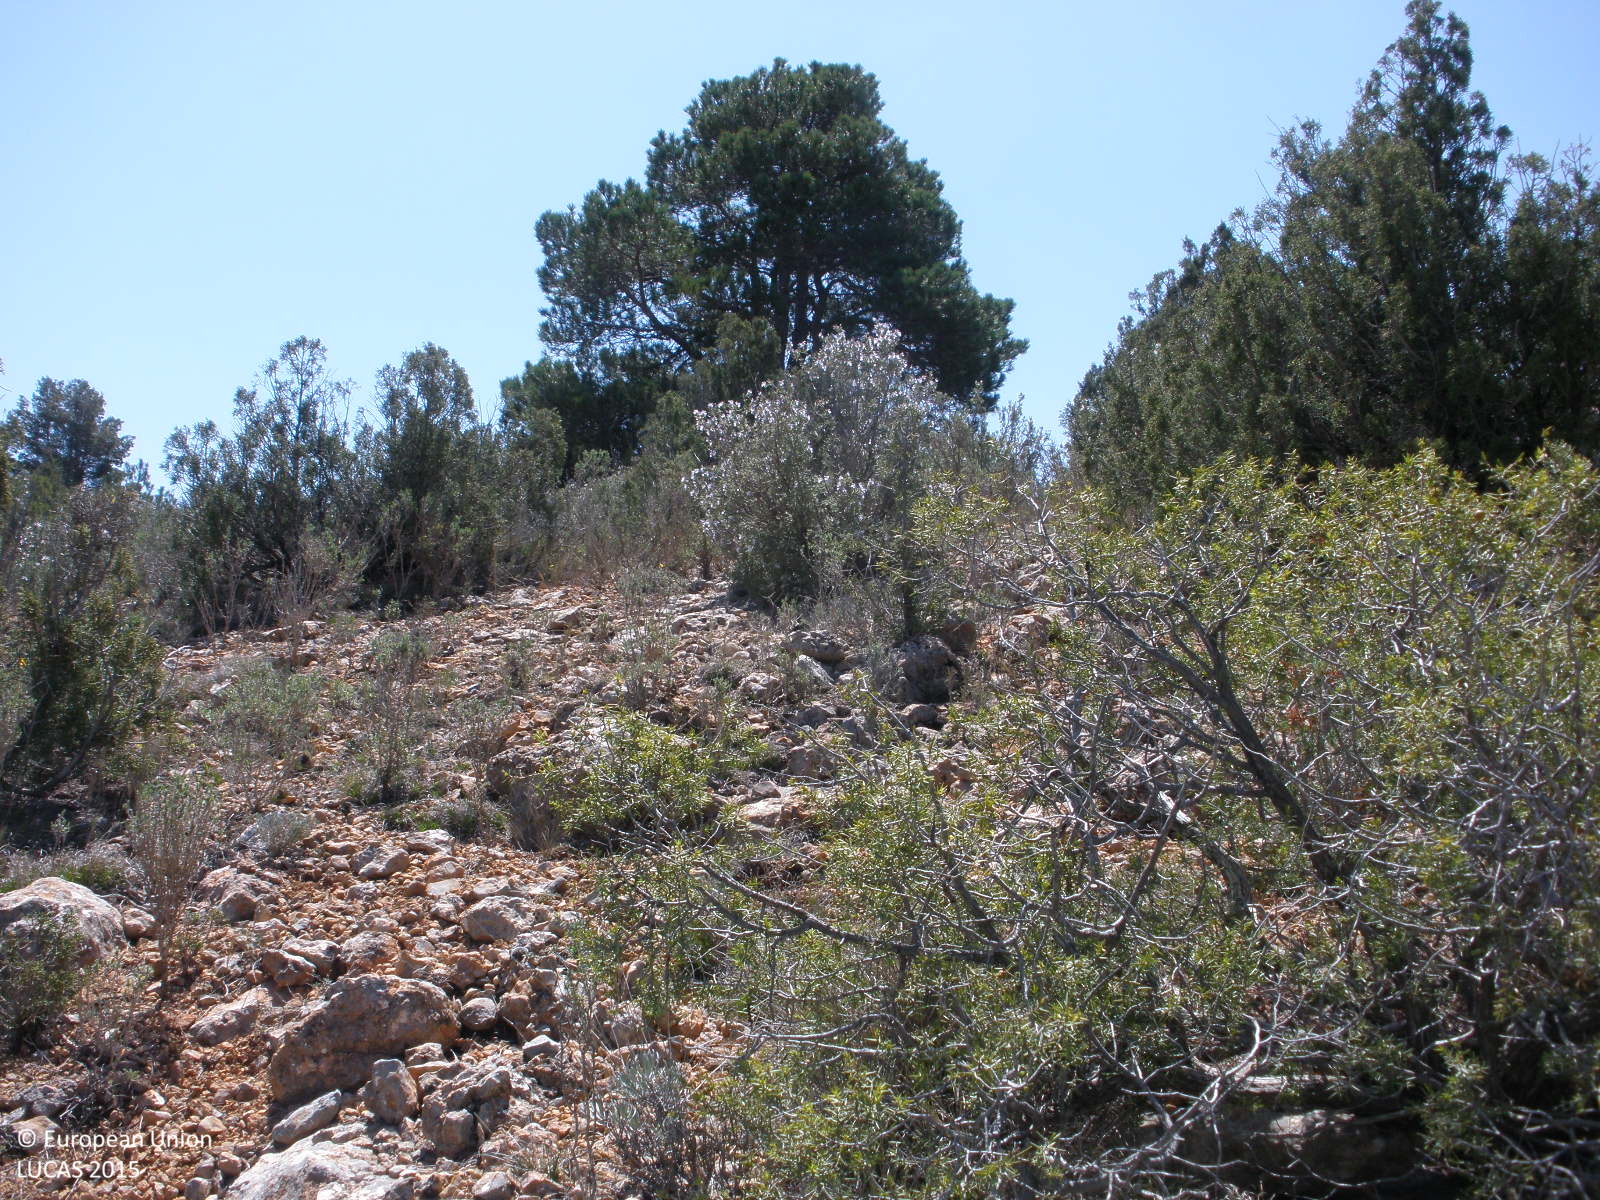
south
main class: Woodland
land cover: Pine dominated coniferous woodland
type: coniferous forest of the mediterranean region
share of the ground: 25 - 50 %
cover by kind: shrubs 50 %, coniferous forest trees 30 %, consolidated bare surface 20 %
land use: Semi-natural and natural areas not in use
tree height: < 5 m
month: April
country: ES
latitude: 40.2018
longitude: -1.2529
